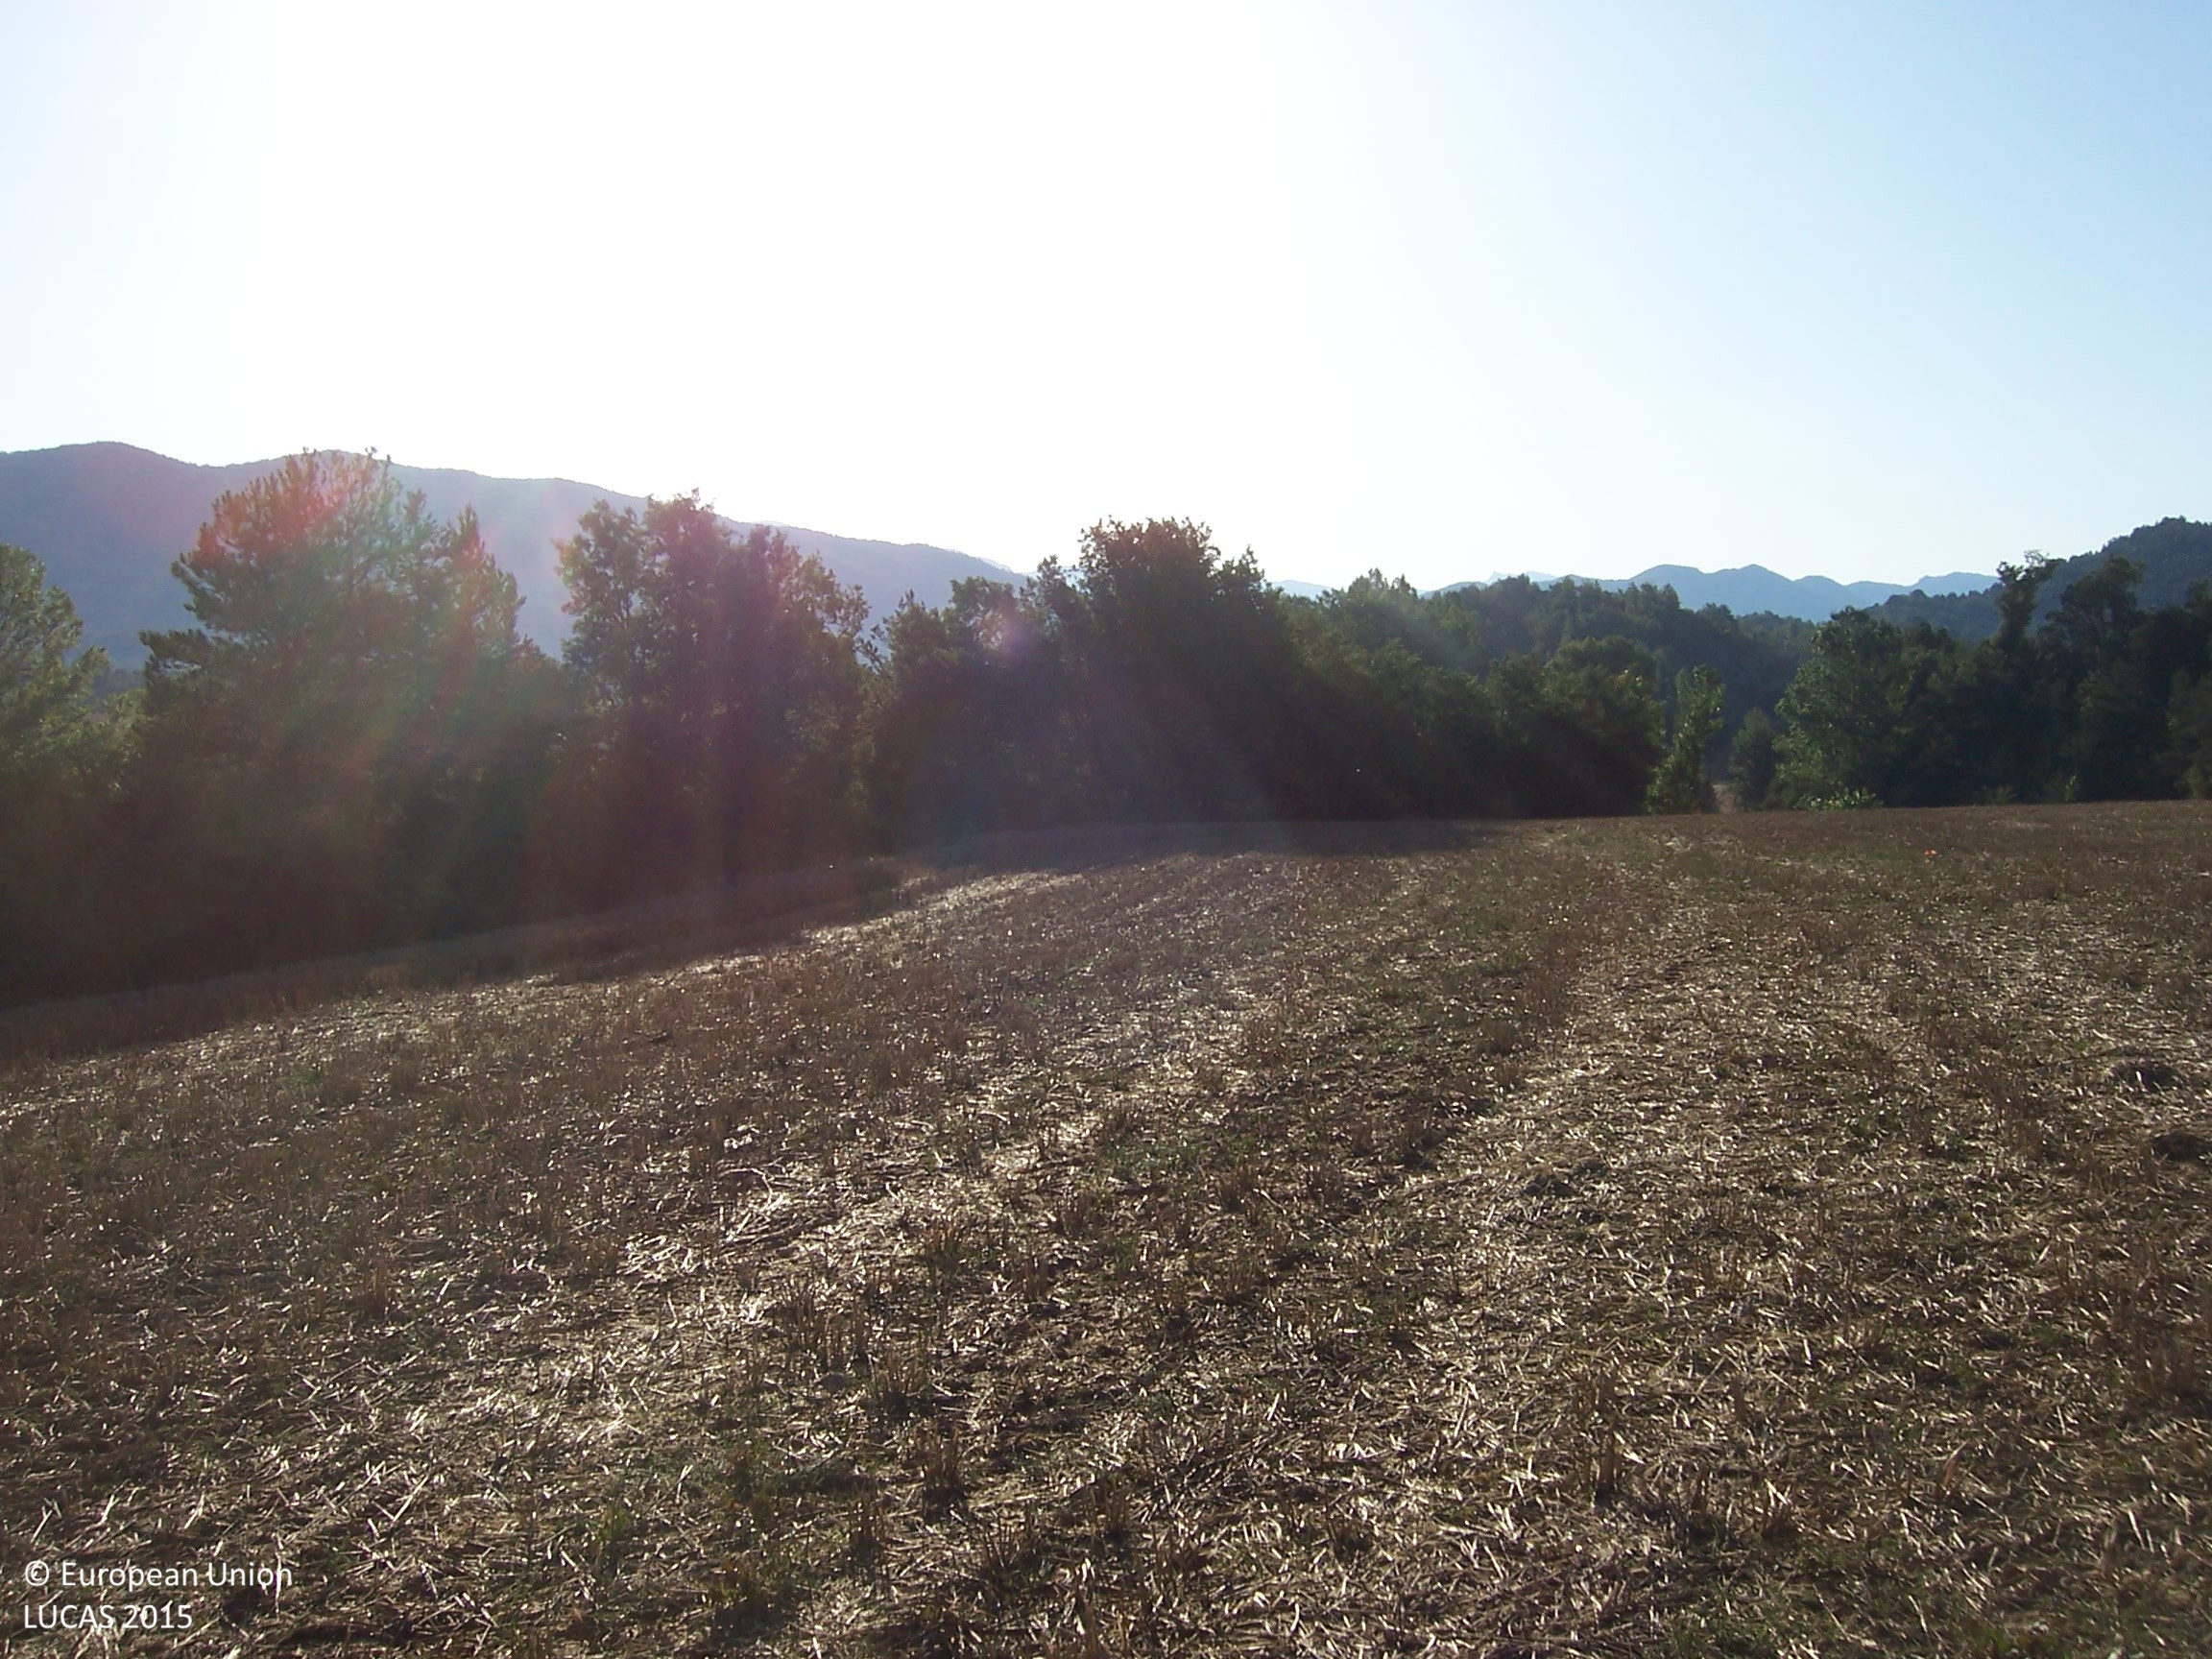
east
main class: Cropland
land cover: Barley
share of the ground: < 10 %
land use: Agriculture (excluding fallow land and kitchen gardens)
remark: Harvested field
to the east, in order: Barley; Pine dominated mixed woodland; Barley; Broadleaved woodland; Rivers and streams; Broadleaved woodland; Common wheat
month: August
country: ES
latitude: 42.4963
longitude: -0.4291
